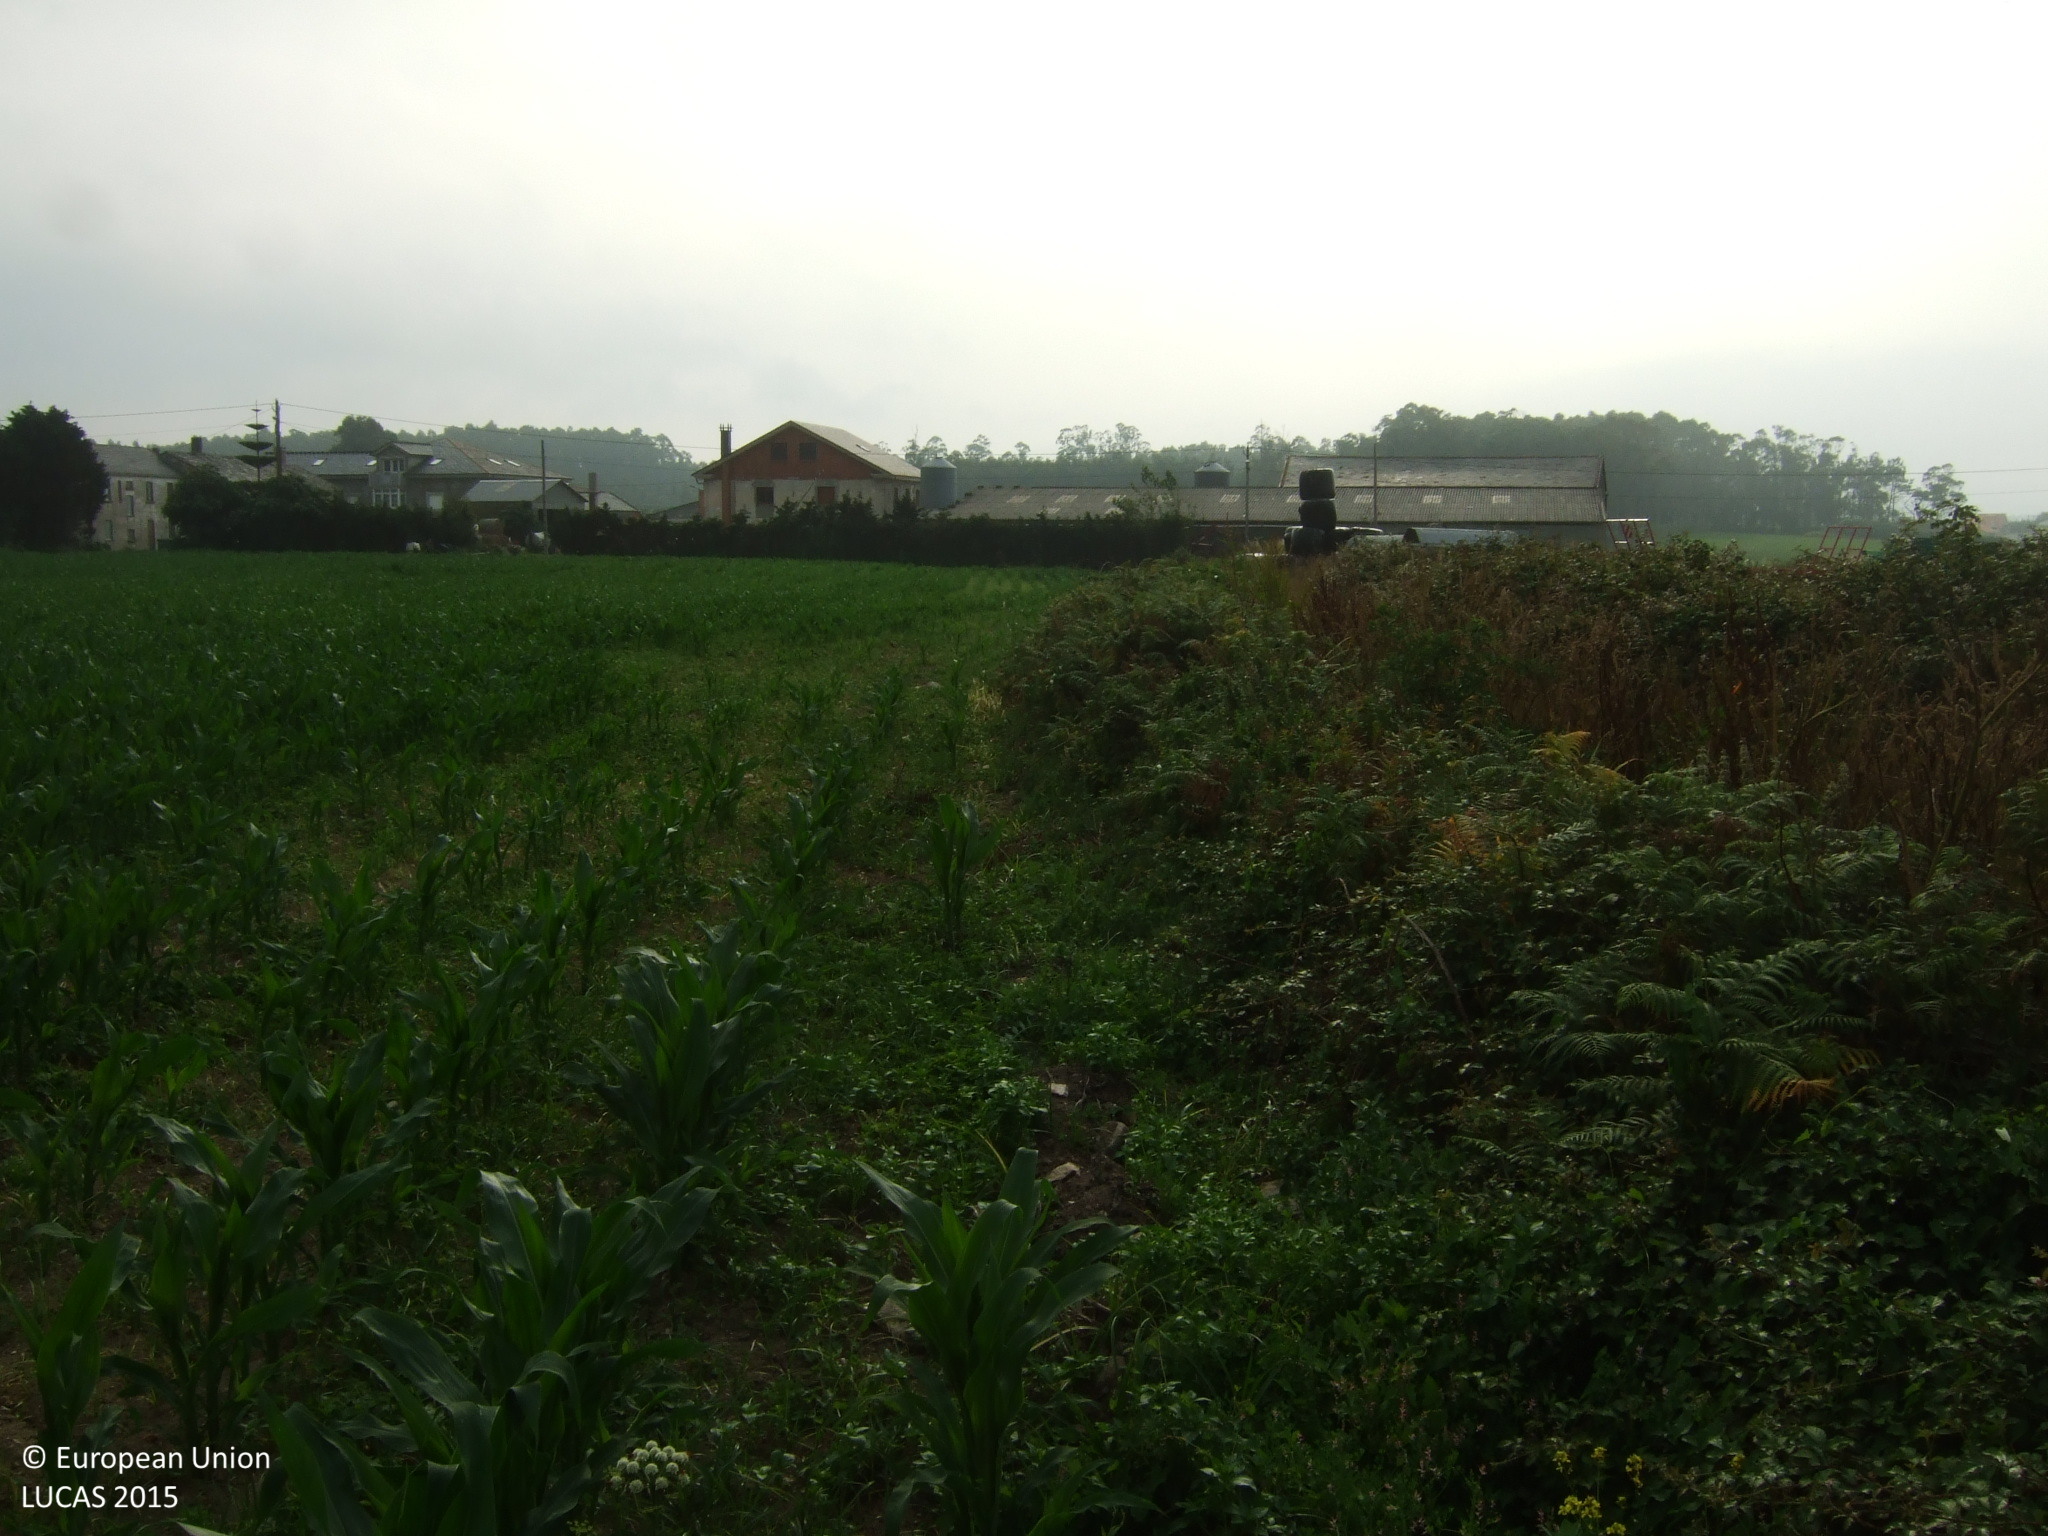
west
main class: Cropland
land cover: Maize
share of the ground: 50 - 75 %
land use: Agriculture (excluding fallow land and kitchen gardens)
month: June
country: ES
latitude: 43.5604
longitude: -7.2206
